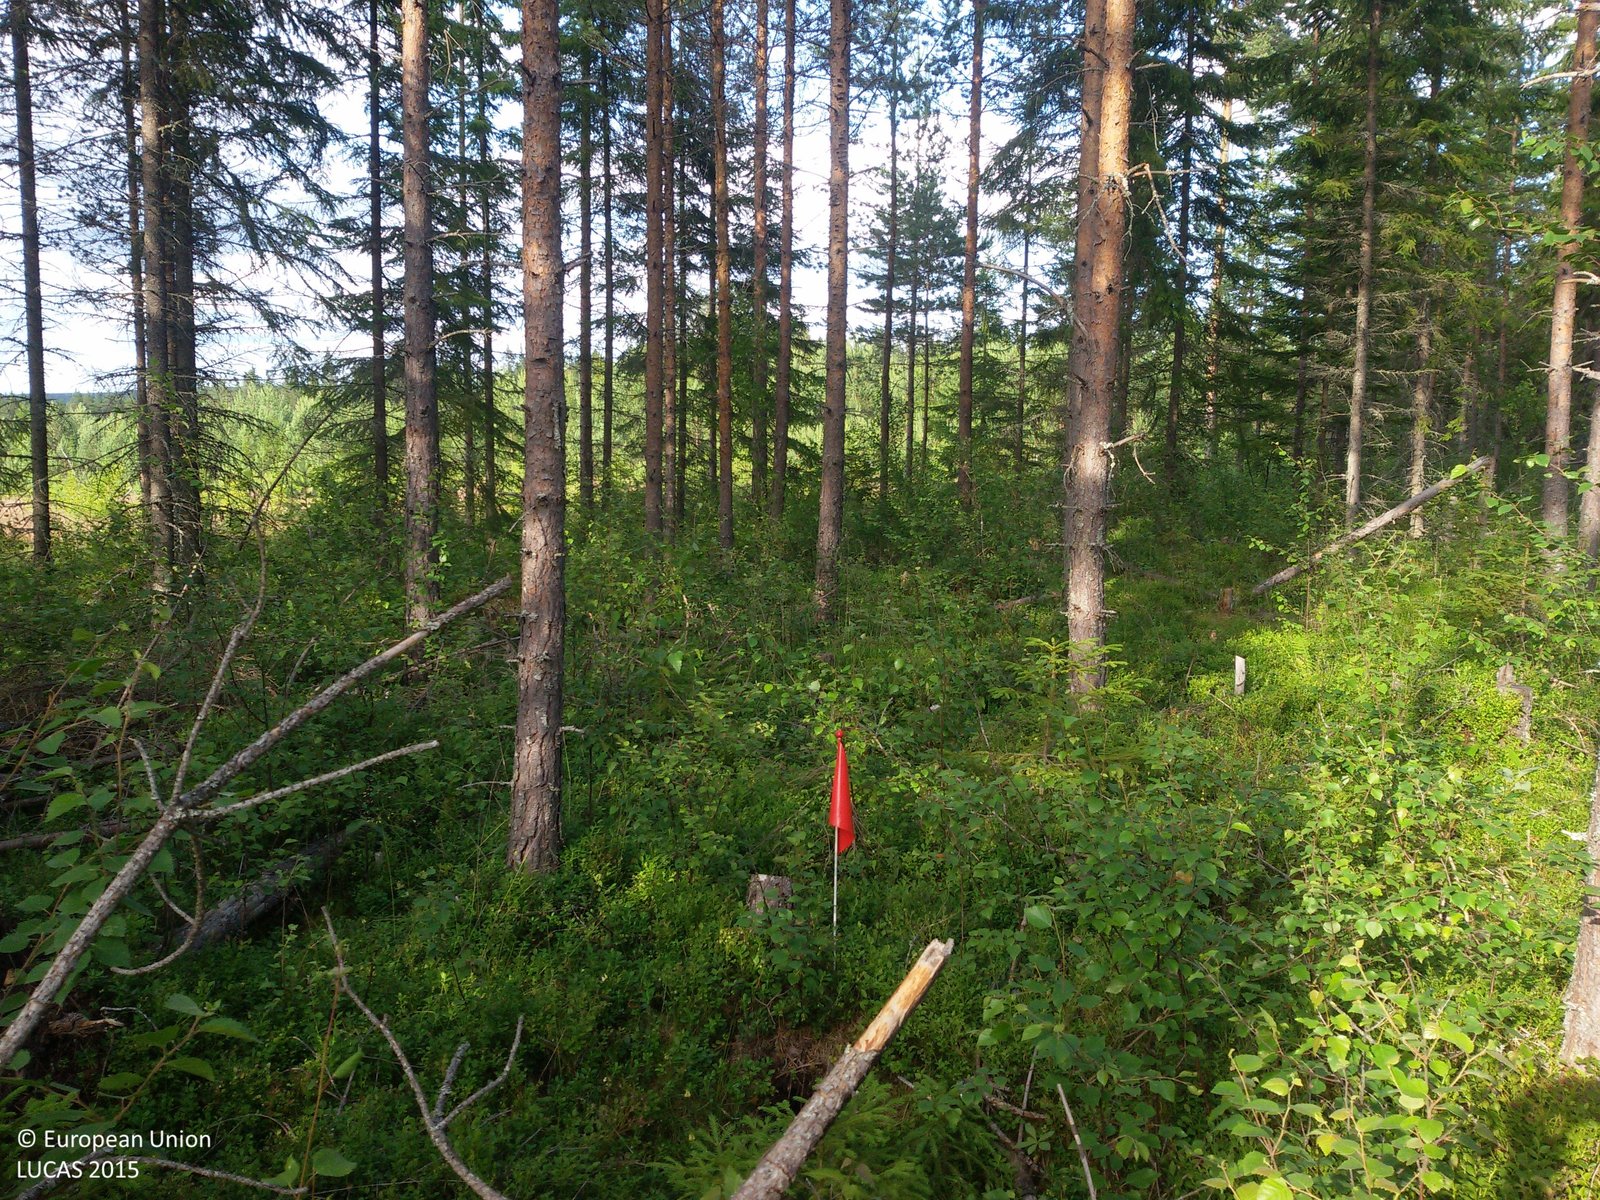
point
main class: Woodland
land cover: Pine dominated coniferous woodland
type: boreal forest
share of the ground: 50 - 75 %
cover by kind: coniferous forest trees 50 %, shrubs 30 %, broadleaved forest trees 10 %, lichens and mosses 10 %
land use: Forestry
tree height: > 5 m
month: July
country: SE
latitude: 60.5147
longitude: 15.2879
